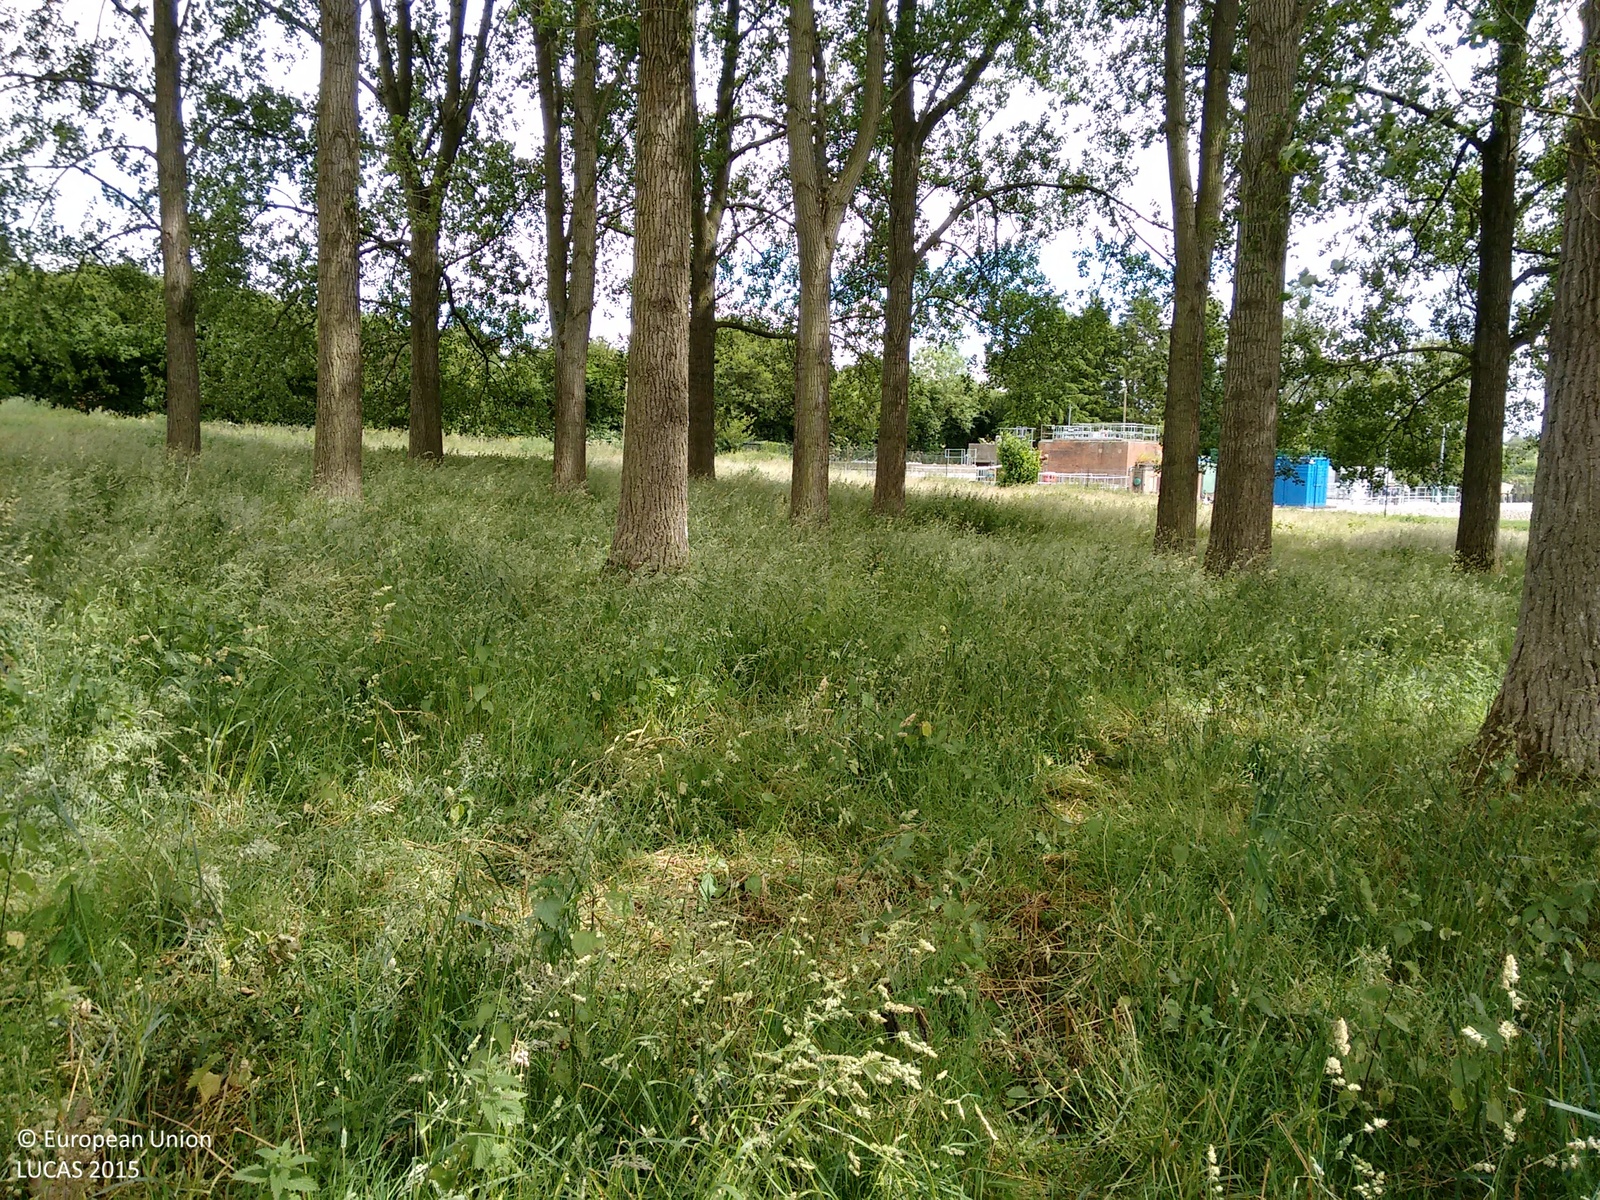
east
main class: Woodland
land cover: Broadleaved woodland
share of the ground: > 75 %
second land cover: Grassland without tree/shrub cover
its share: 10 - 25 %
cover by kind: broadleaved forest trees 80 %, herbaceous plants 20 %
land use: Waste treatment
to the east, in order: Broadleaved woodland; Grassland without tree/shrub cover; Fences; Tracks; Managed hedges; Fences; Grassland without tree/shrub cover
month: June
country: GB
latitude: 51.4790
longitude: -1.2355
